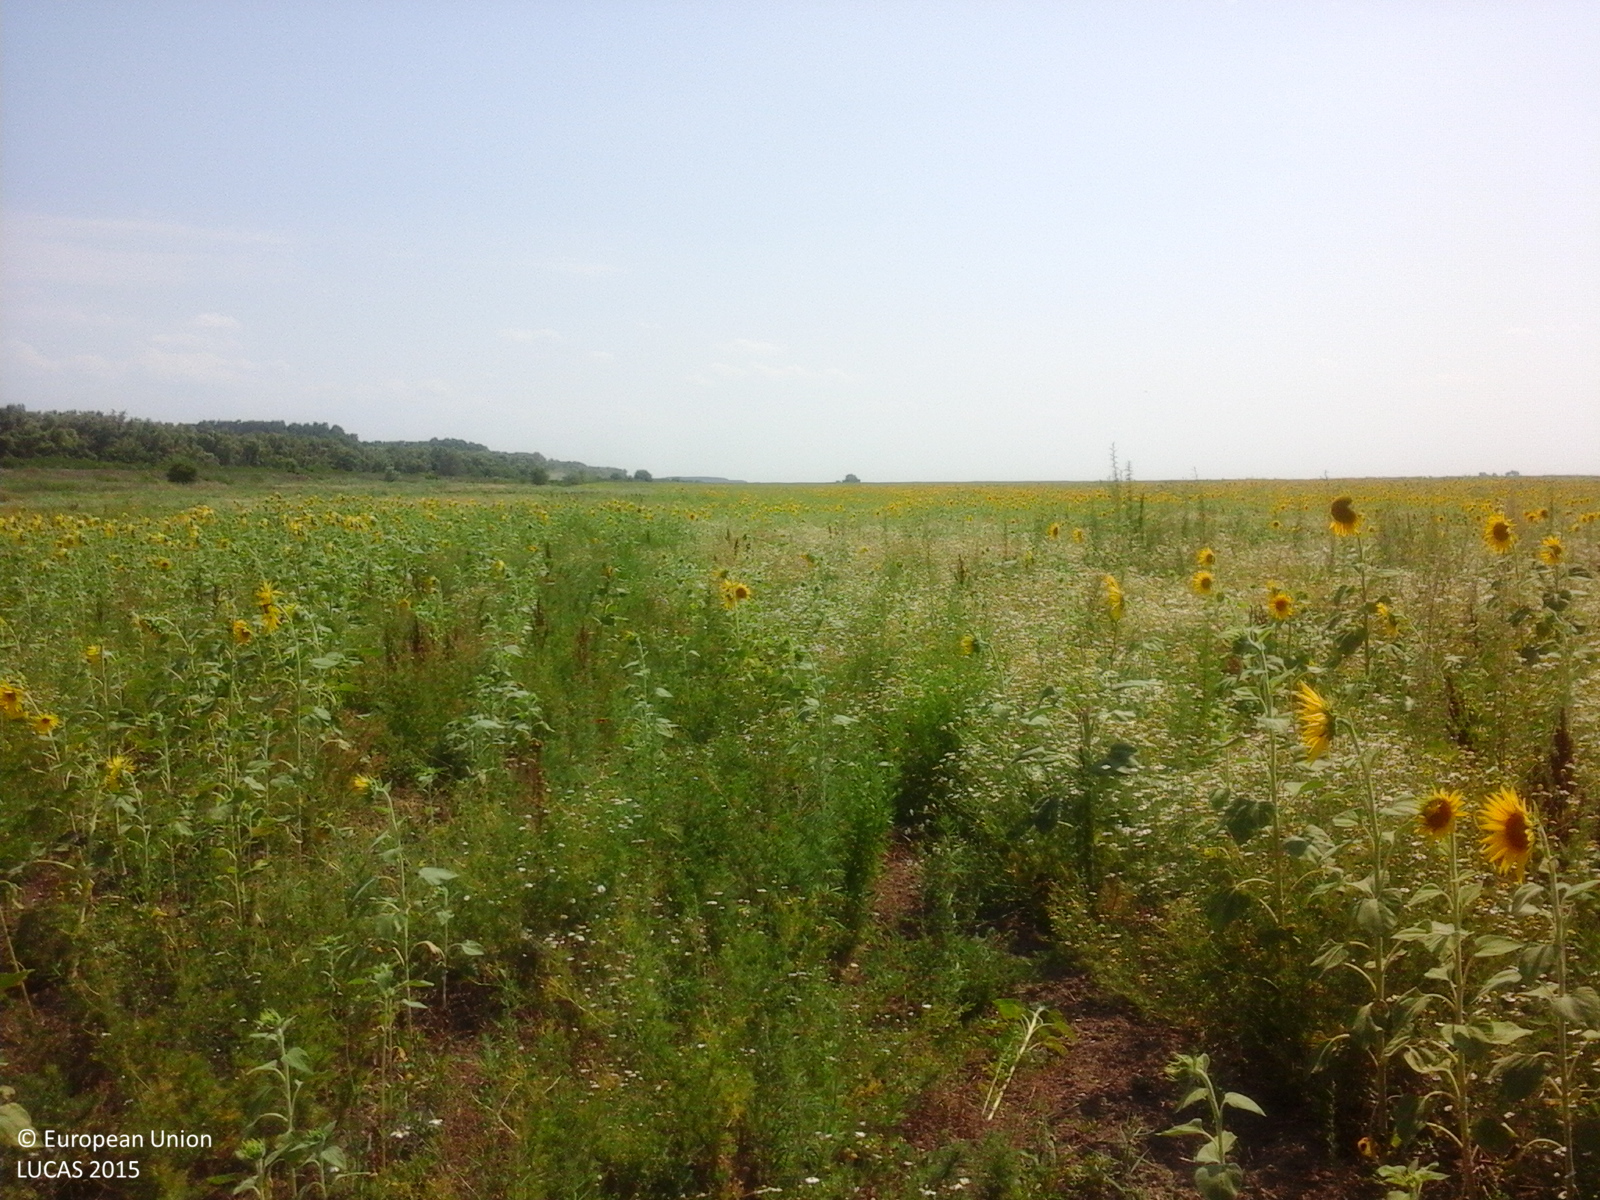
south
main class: Cropland
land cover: Sunflower
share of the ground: 50 - 75 %
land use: Agriculture (excluding fallow land and kitchen gardens)
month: July
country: RO
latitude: 44.5853
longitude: 28.0067
